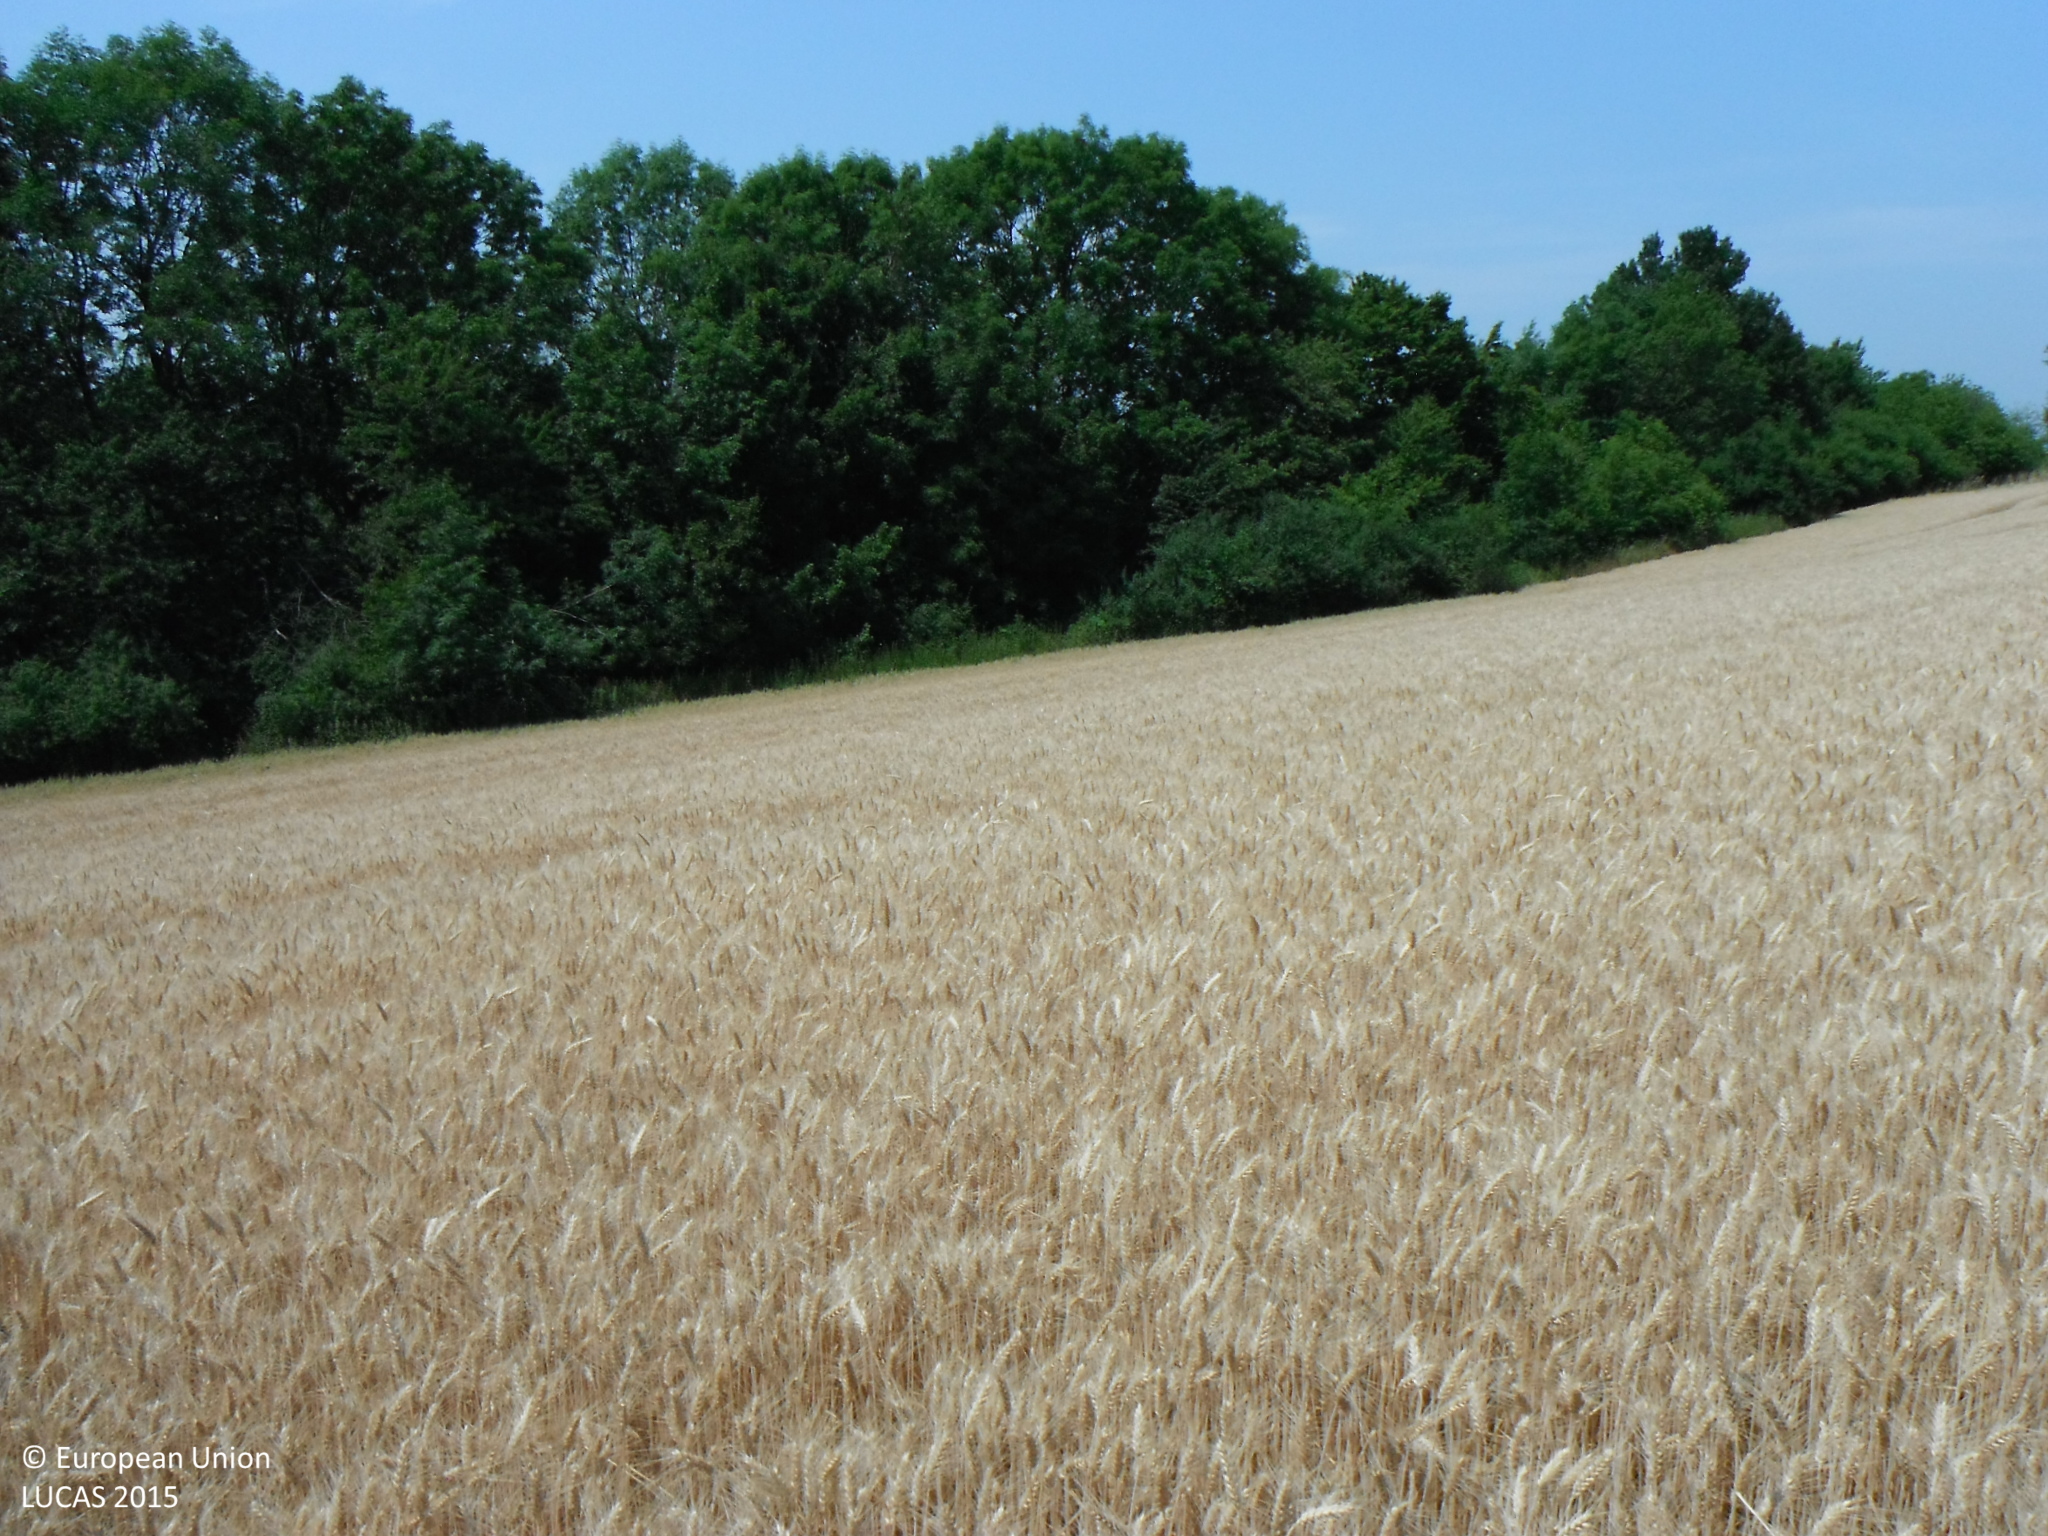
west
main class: Cropland
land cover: Common wheat
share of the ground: > 75 %
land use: Agriculture (excluding fallow land and kitchen gardens)
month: July
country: SK
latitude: 48.2061
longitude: 19.1307
